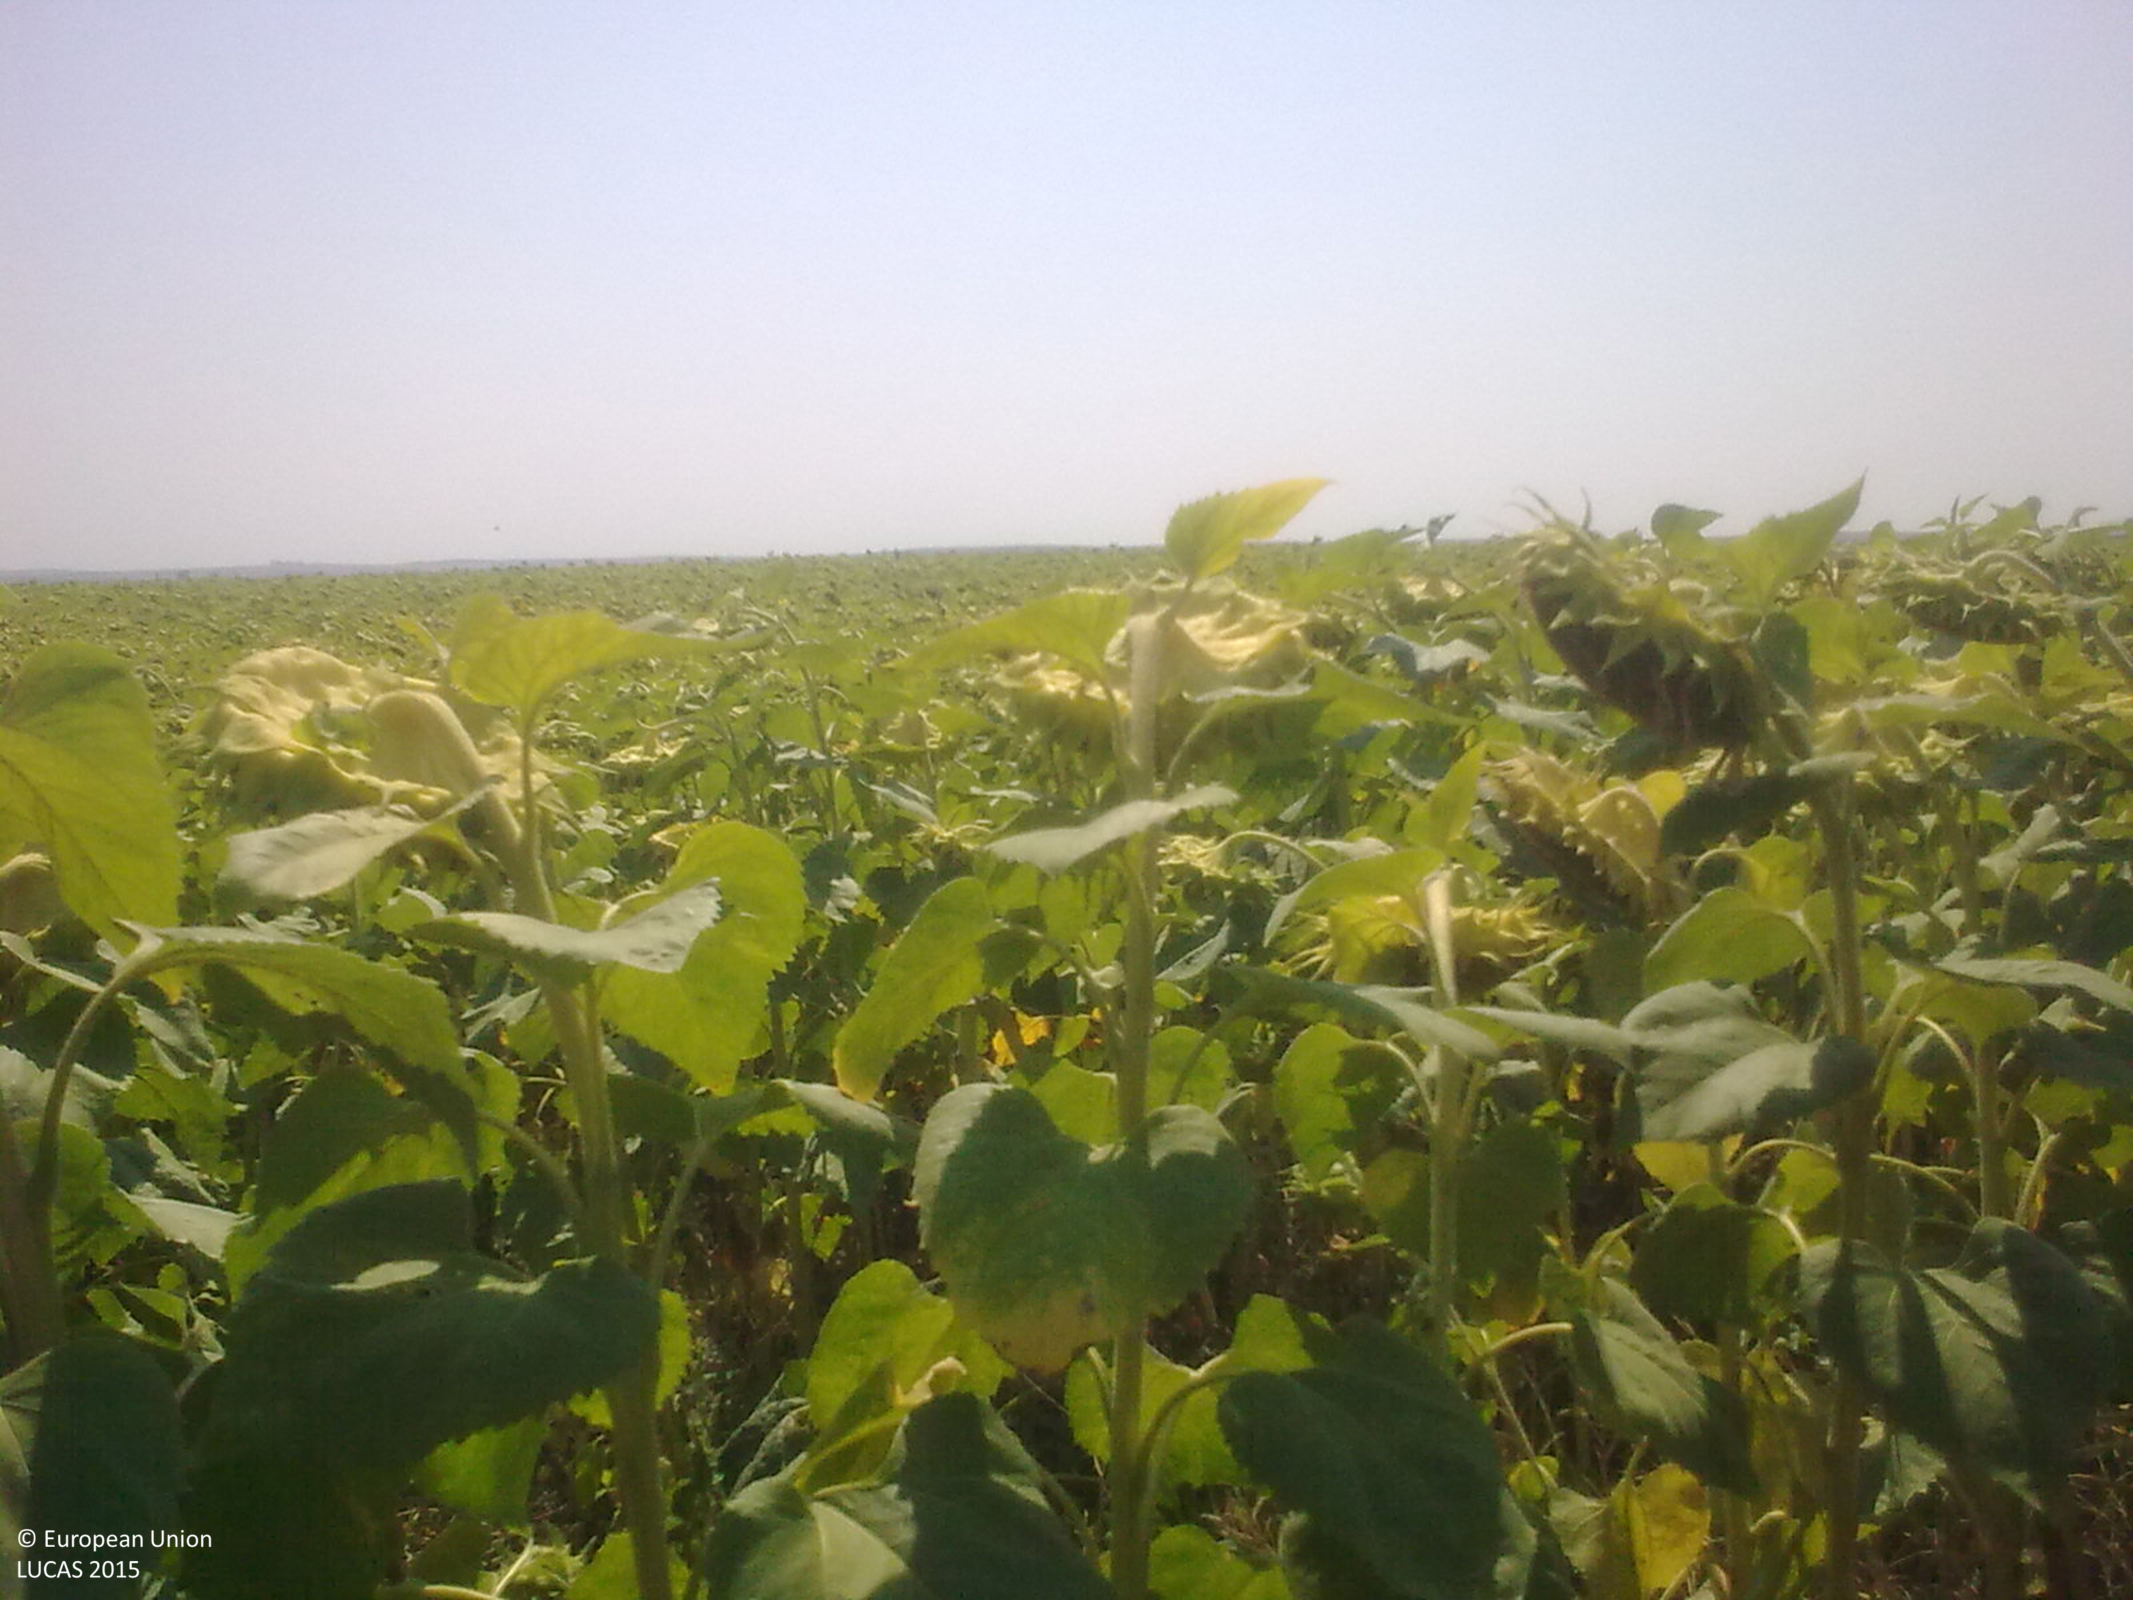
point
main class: Cropland
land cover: Sunflower
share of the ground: > 75 %
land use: Agriculture (excluding fallow land and kitchen gardens)
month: July
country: BG
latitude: 43.8981
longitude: 26.1736
